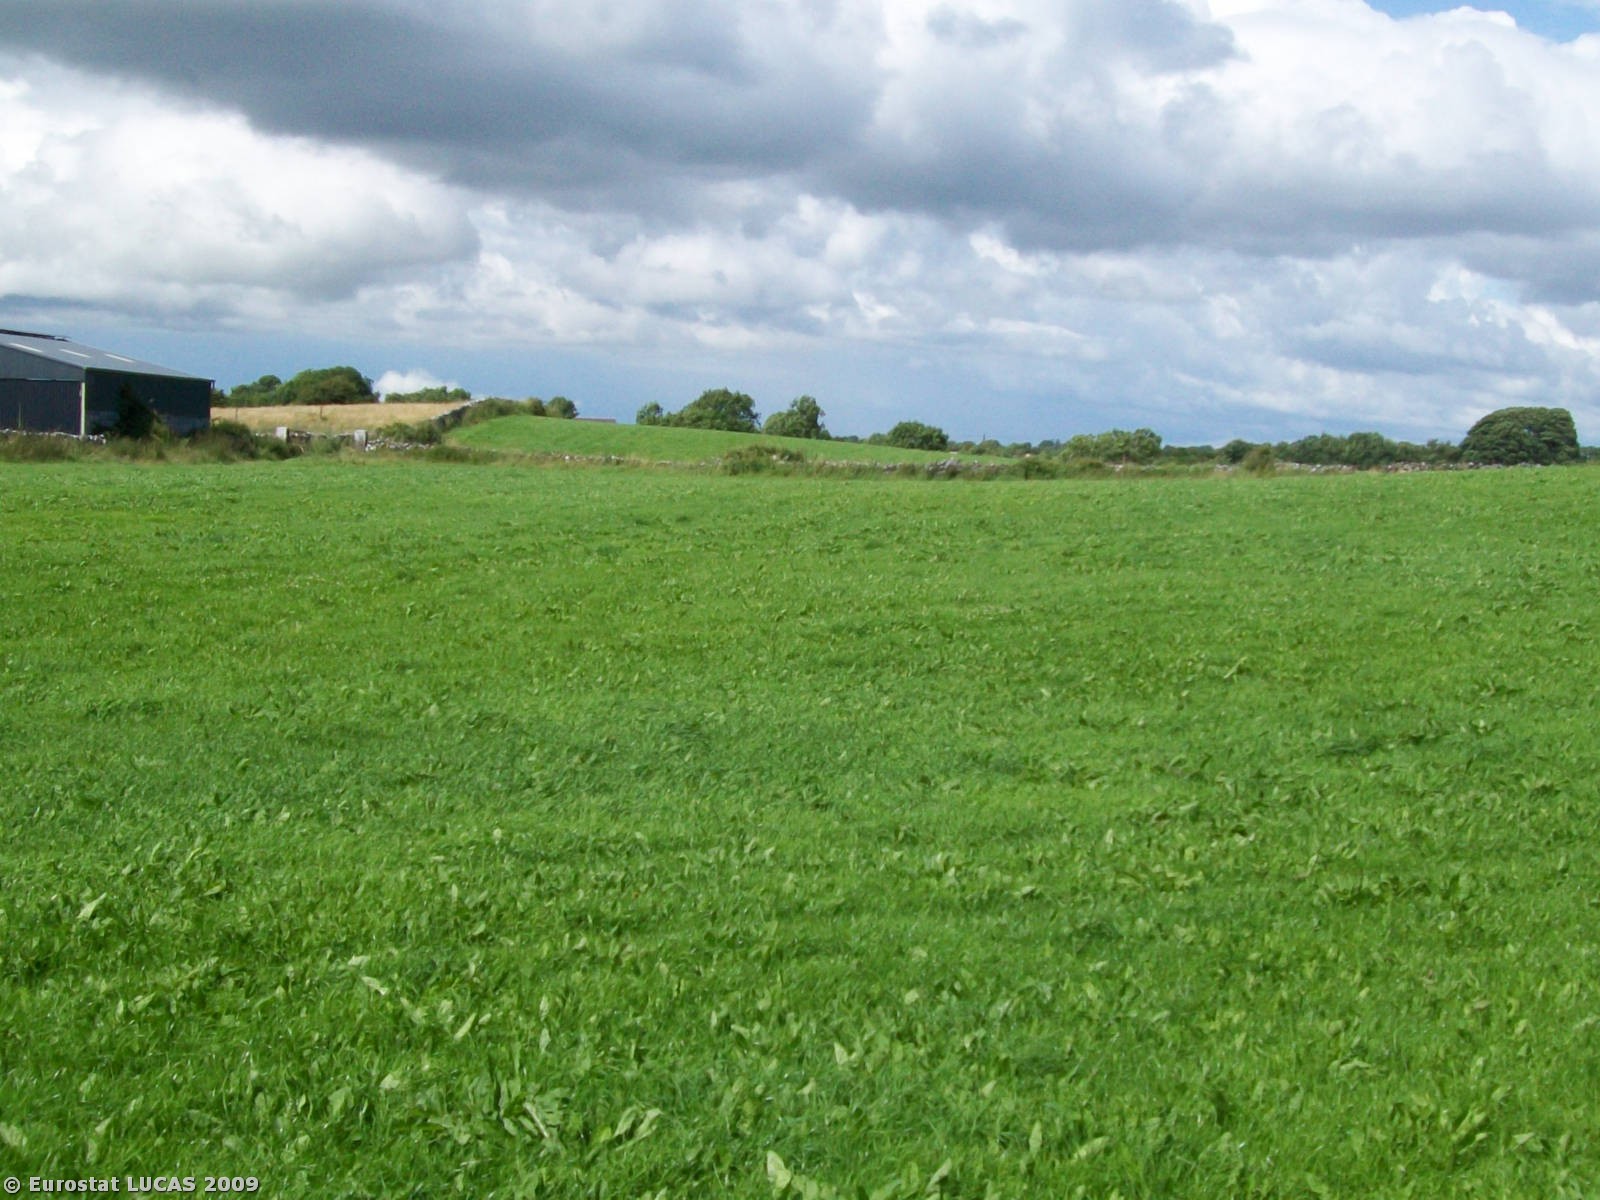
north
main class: Grassland
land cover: Grassland without tree/shrub cover
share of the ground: > 75 %
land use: Agriculture (excluding fallow land and kitchen gardens)
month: July
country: IE
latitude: 53.1811
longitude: -8.7112
